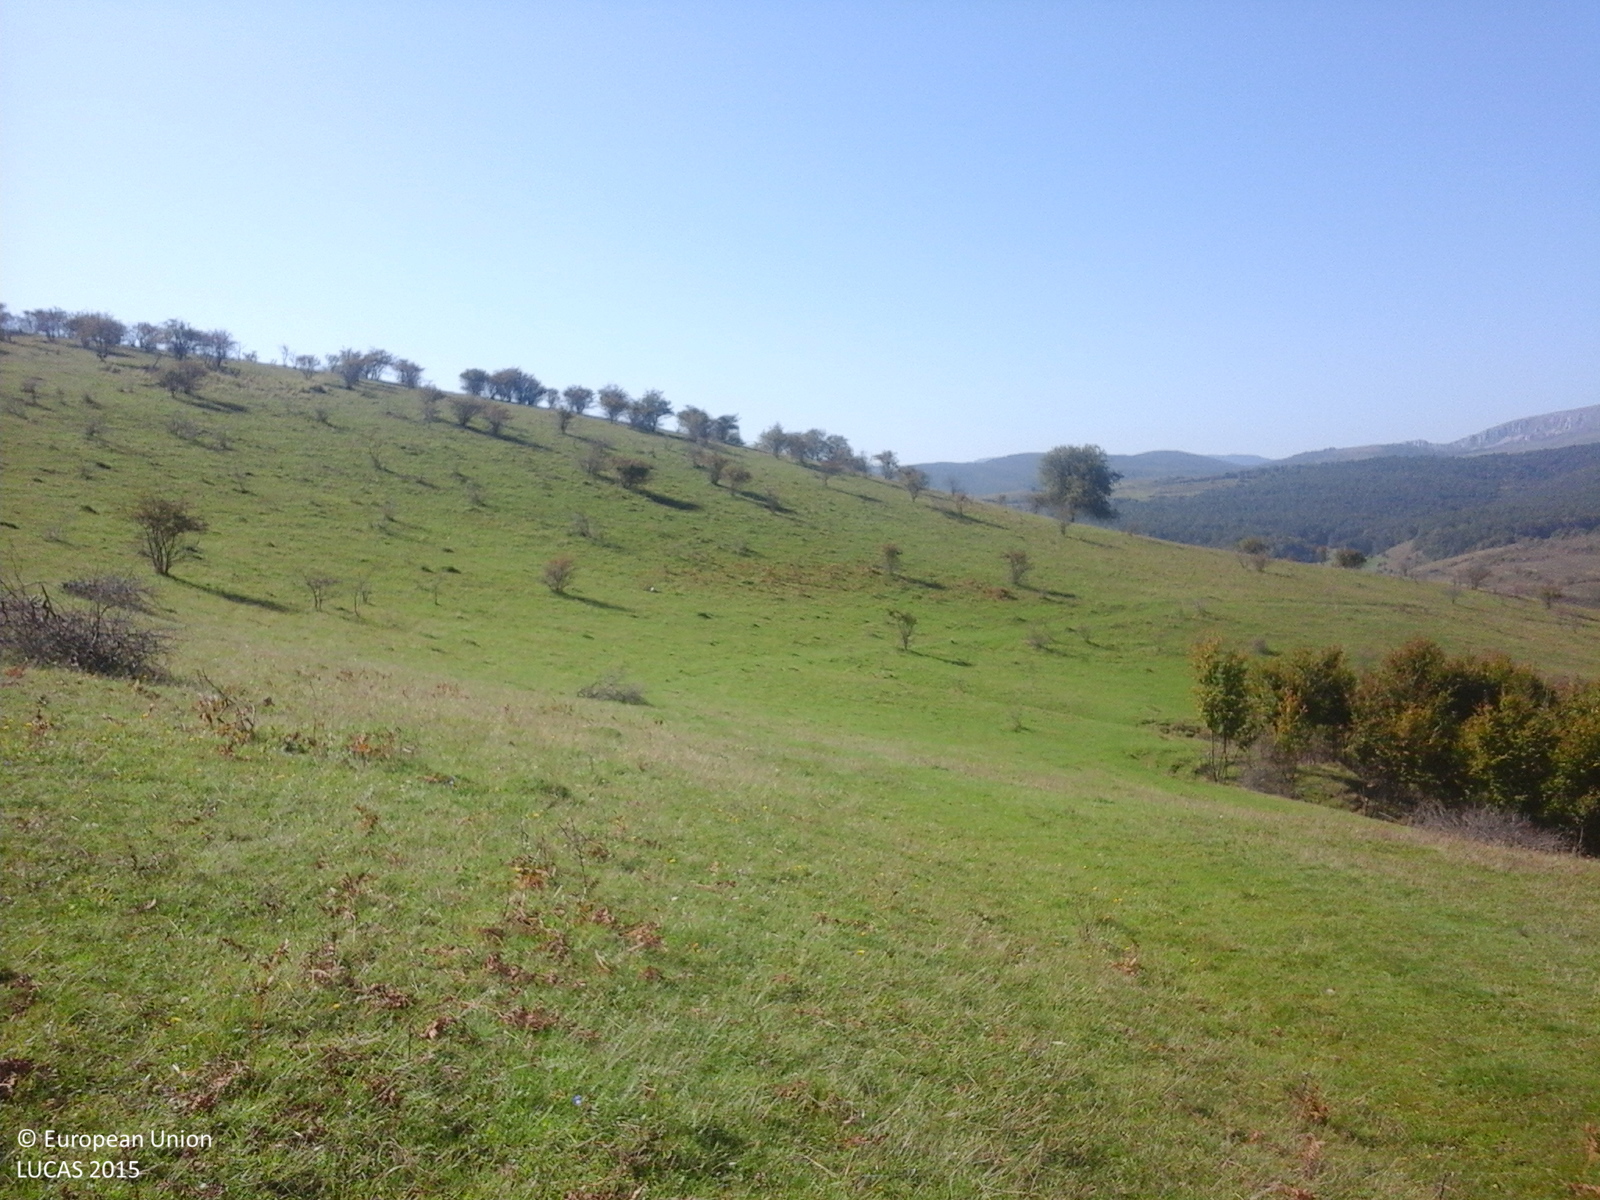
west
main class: Grassland
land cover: Grassland without tree/shrub cover
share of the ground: > 75 %
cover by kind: herbaceous plants 100 %
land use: Agriculture (excluding fallow land and kitchen gardens)
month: October
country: RO
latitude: 46.4151
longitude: 23.6921
